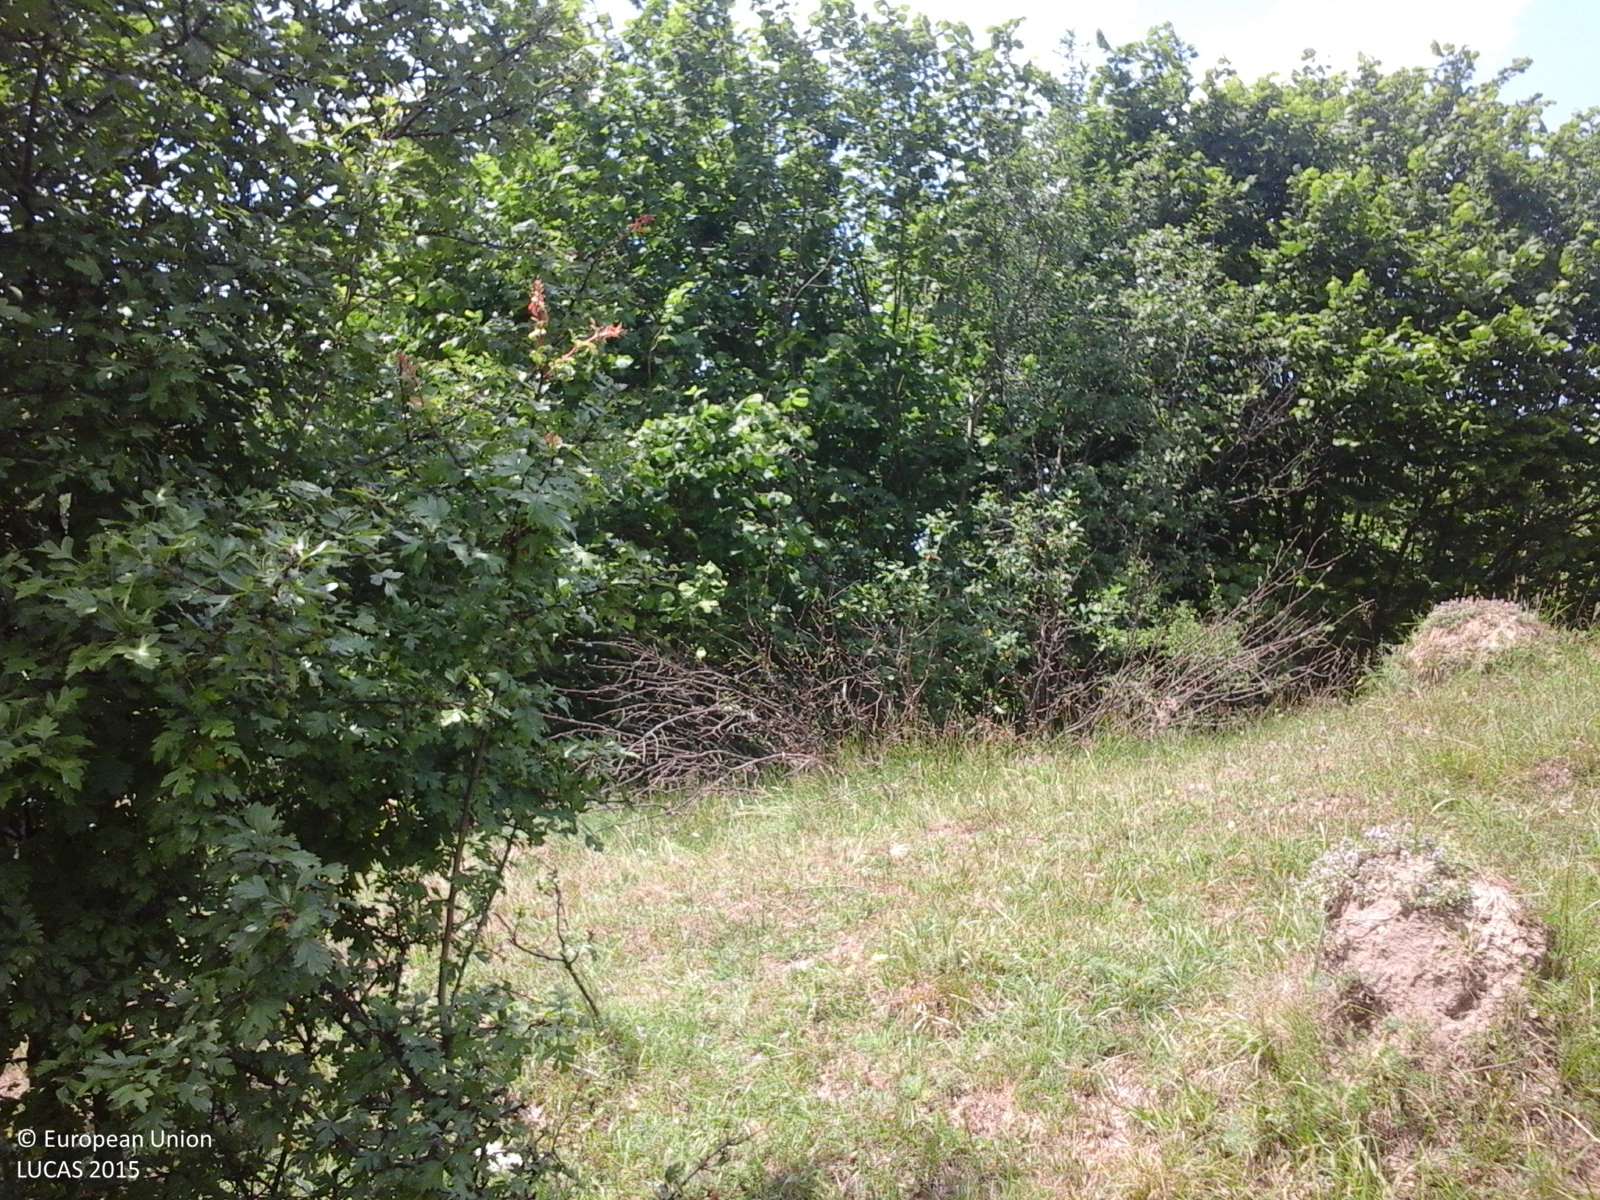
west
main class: Grassland
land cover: Grassland with sparse tree/shrub cover
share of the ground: > 75 %
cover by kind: herbaceous plants 85 %, shrubs 10 %, broadleaved forest trees 5 %
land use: Agriculture (excluding fallow land and kitchen gardens)
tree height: > 5 m
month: June
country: RO
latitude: 47.7805
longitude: 25.8623
